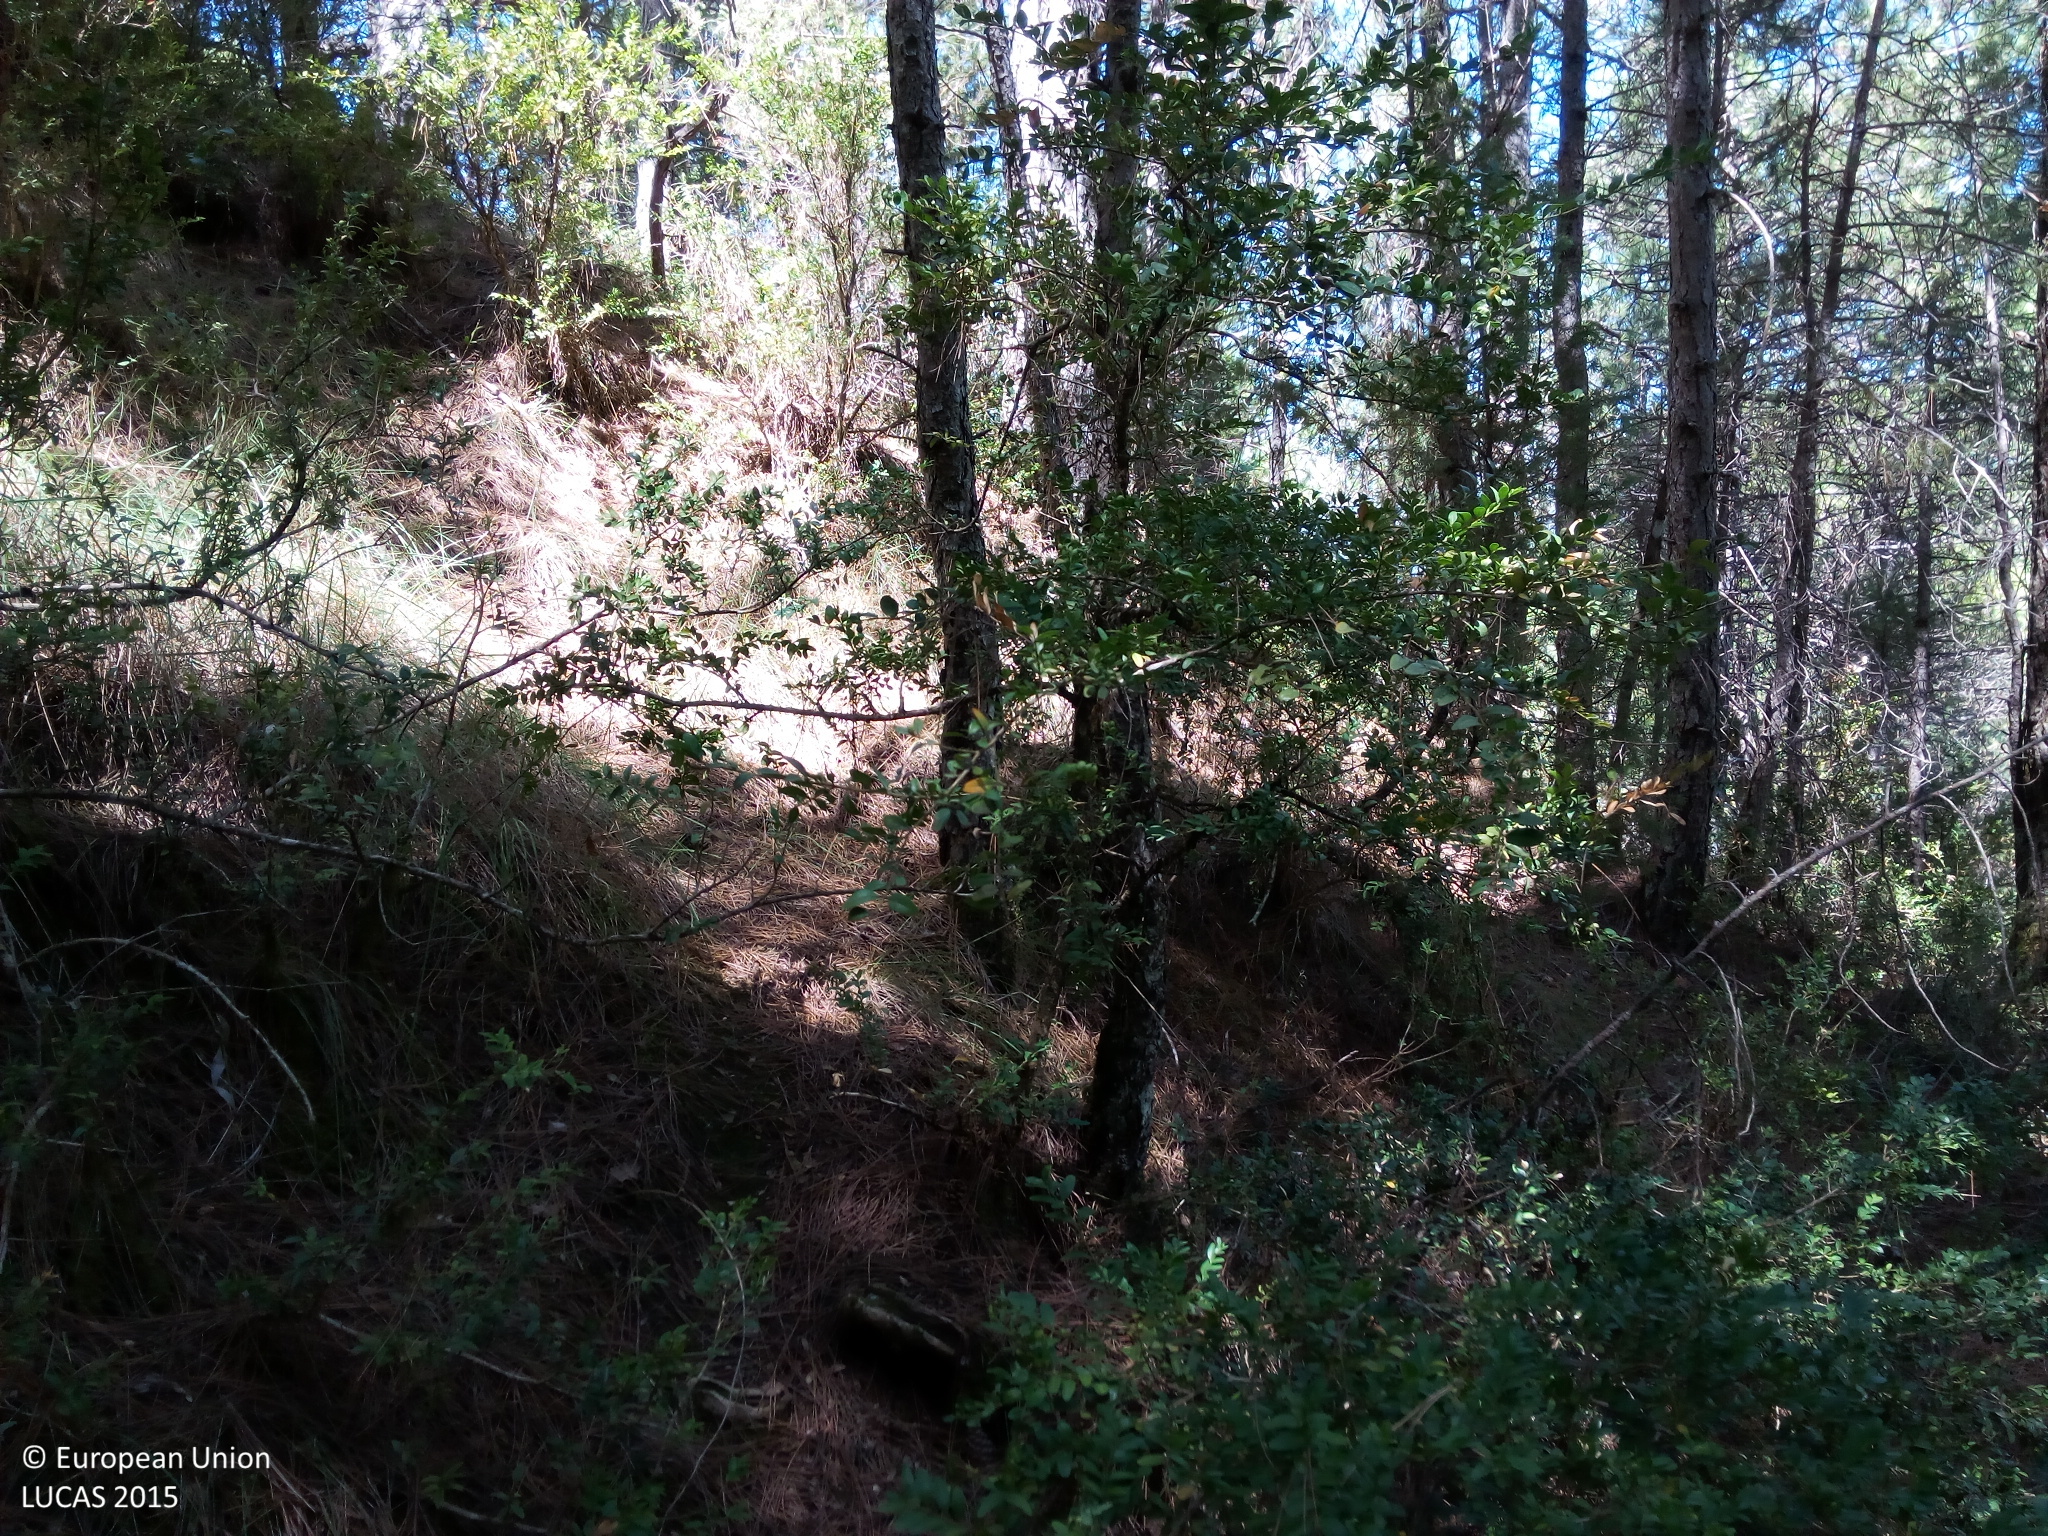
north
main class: Woodland
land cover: Pine dominated coniferous woodland
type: coniferous forest of the mediterranean region
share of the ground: > 75 %
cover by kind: coniferous forest trees 100 %
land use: Forestry
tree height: > 5 m
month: August
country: ES
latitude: 42.4651
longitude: 0.1641
